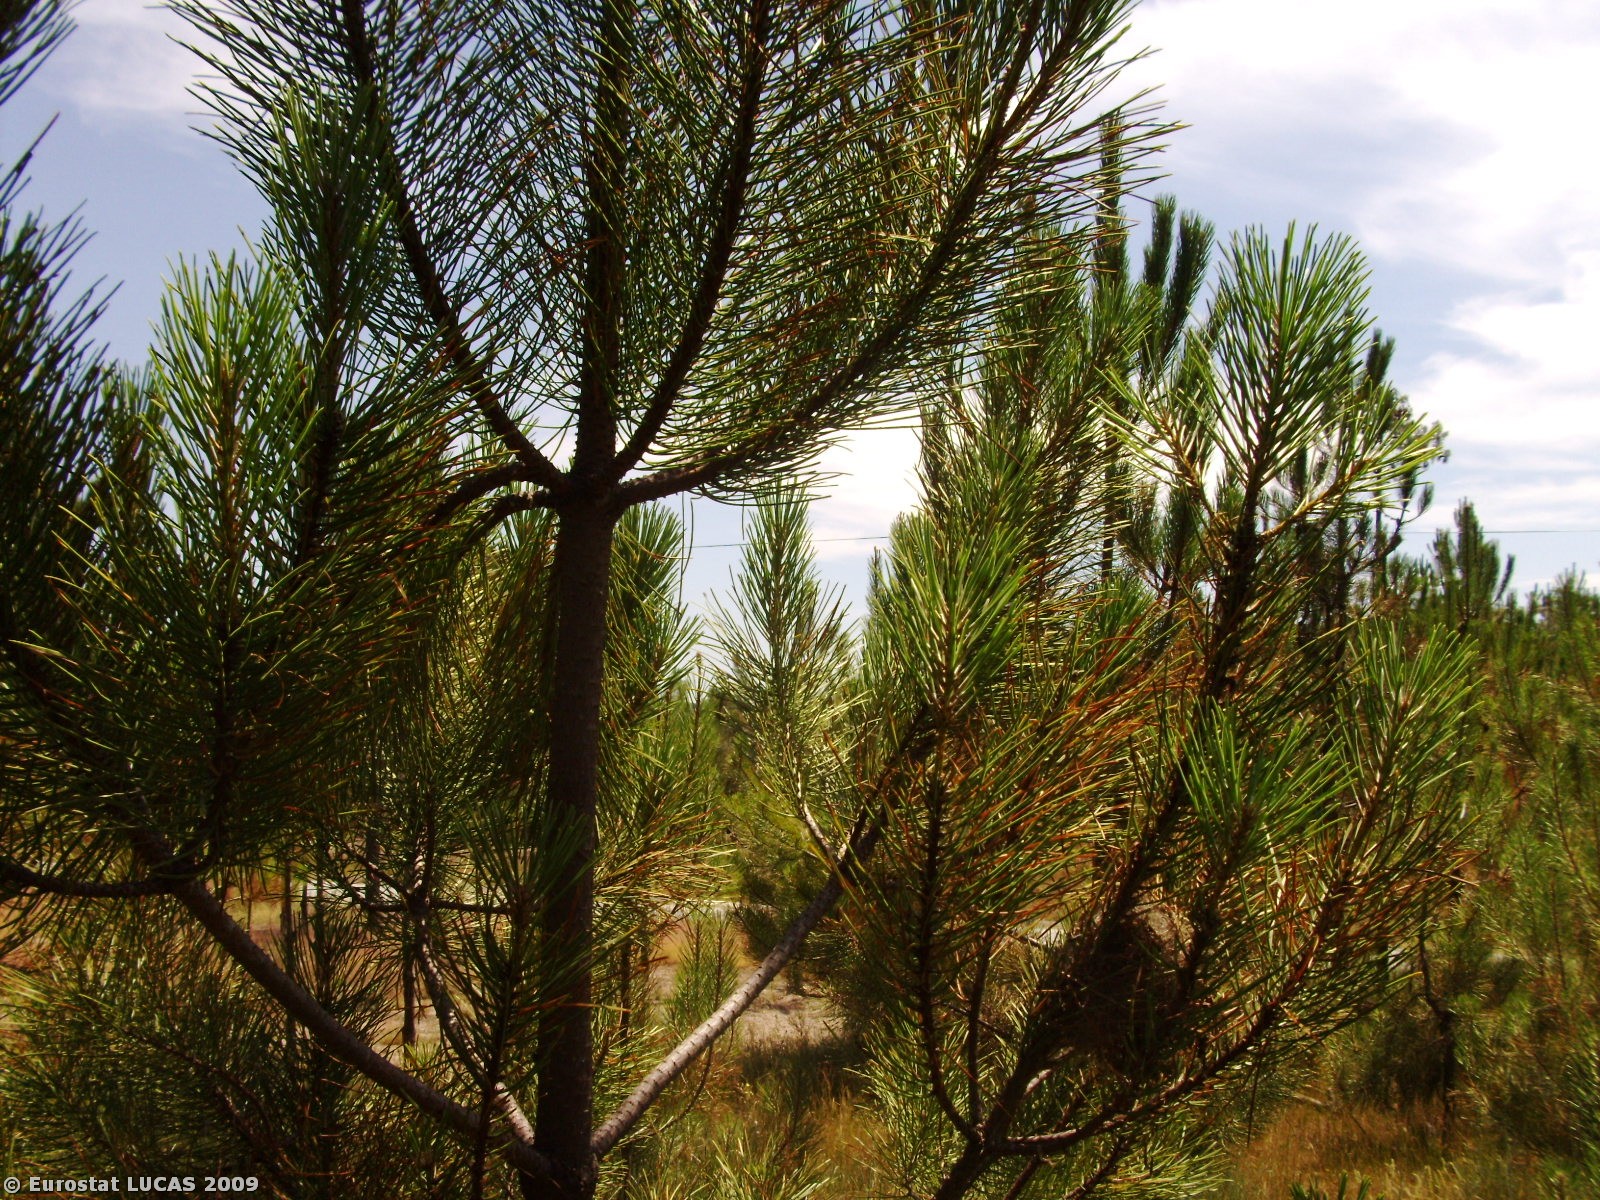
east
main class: Woodland
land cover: Coniferous woodland
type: coniferous forest of the mediterranean region
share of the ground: > 75 %
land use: Forestry
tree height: > 5 m
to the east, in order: Coniferous woodland; Paved roads, cycling and walking lanes; Electric lines; Shrubland without tree cover; Maize; Shrubland without tree cover; Electric lines; Shrubland without tree cover; Broadleaved woodland; Tracks; Dry stone walls; Coniferous woodland; Shrubland without tree cover; Spontaneously vegetated surfaces; Maize; Shrubland without tree cover
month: July
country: PT
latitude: 40.8871
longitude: -7.7483
